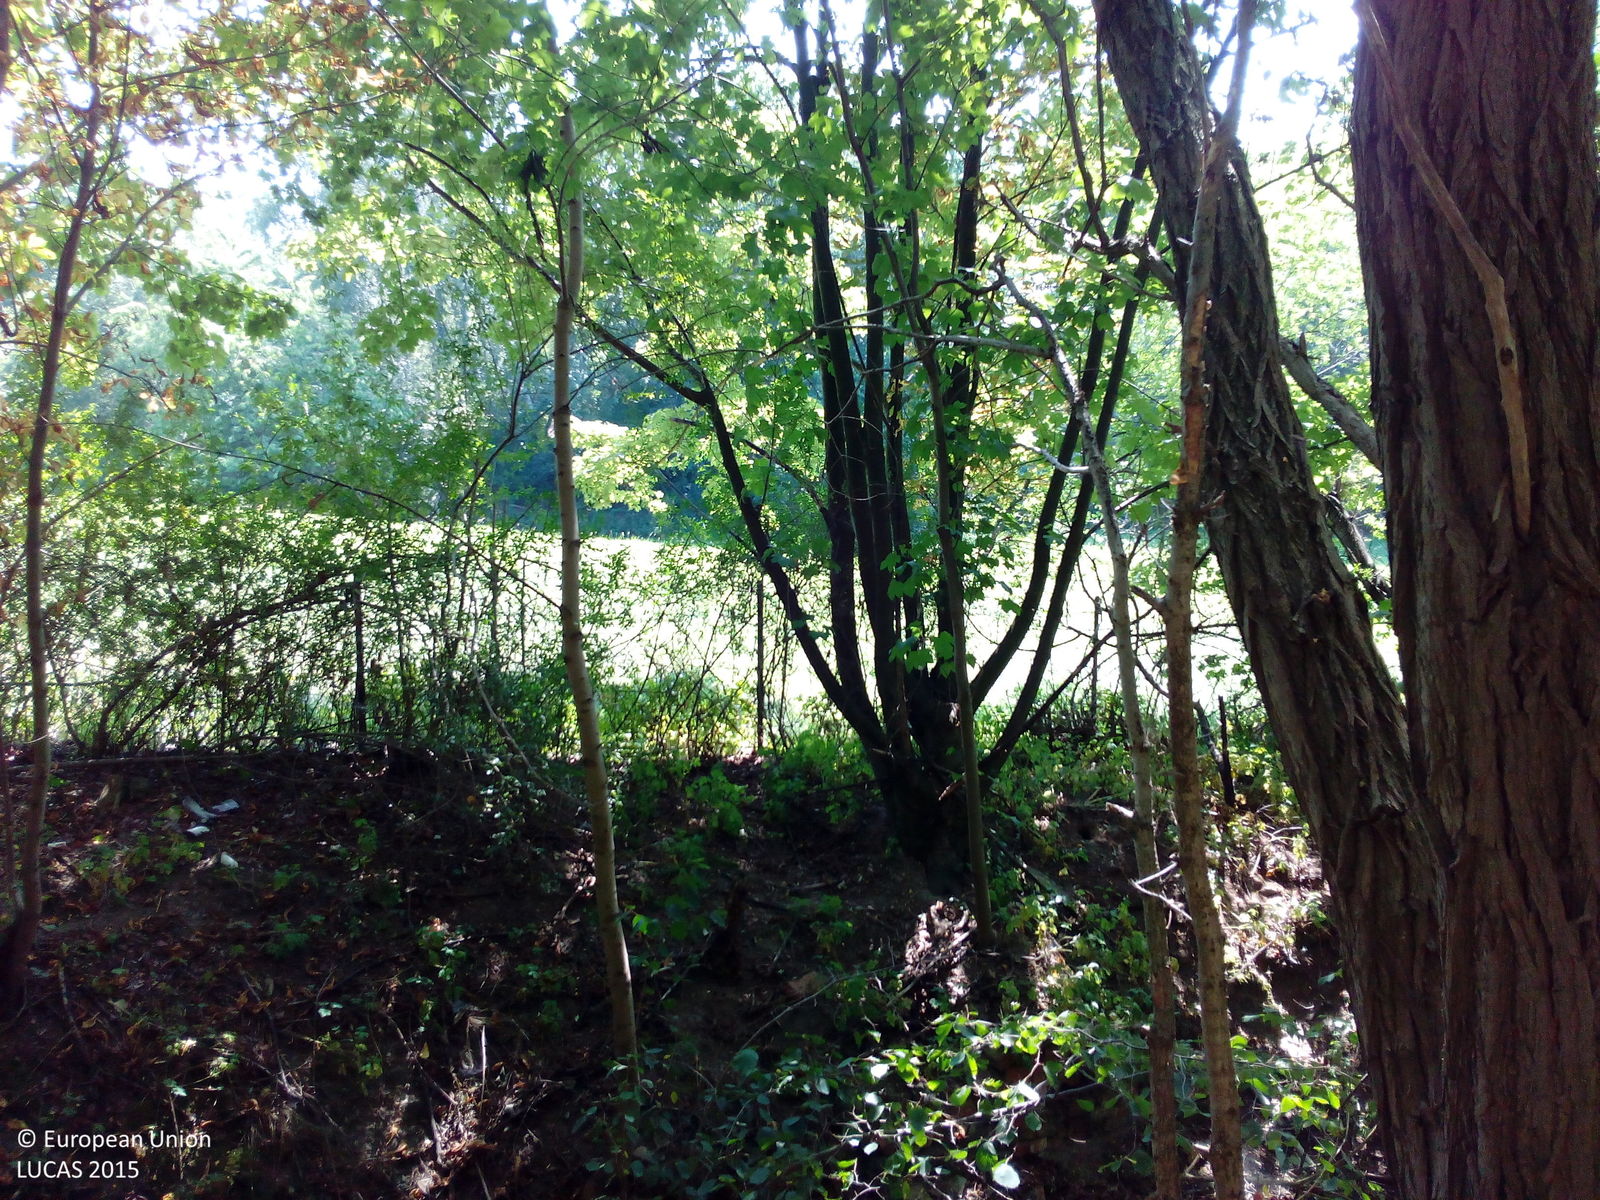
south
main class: Woodland
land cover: Broadleaved woodland
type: mesophytic deciduous forest
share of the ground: > 75 %
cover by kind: broadleaved forest trees 95 %, unconsolidated bare surface 5 %
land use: Forestry
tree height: > 5 m
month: August
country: DE
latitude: 51.8697
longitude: 11.0309
